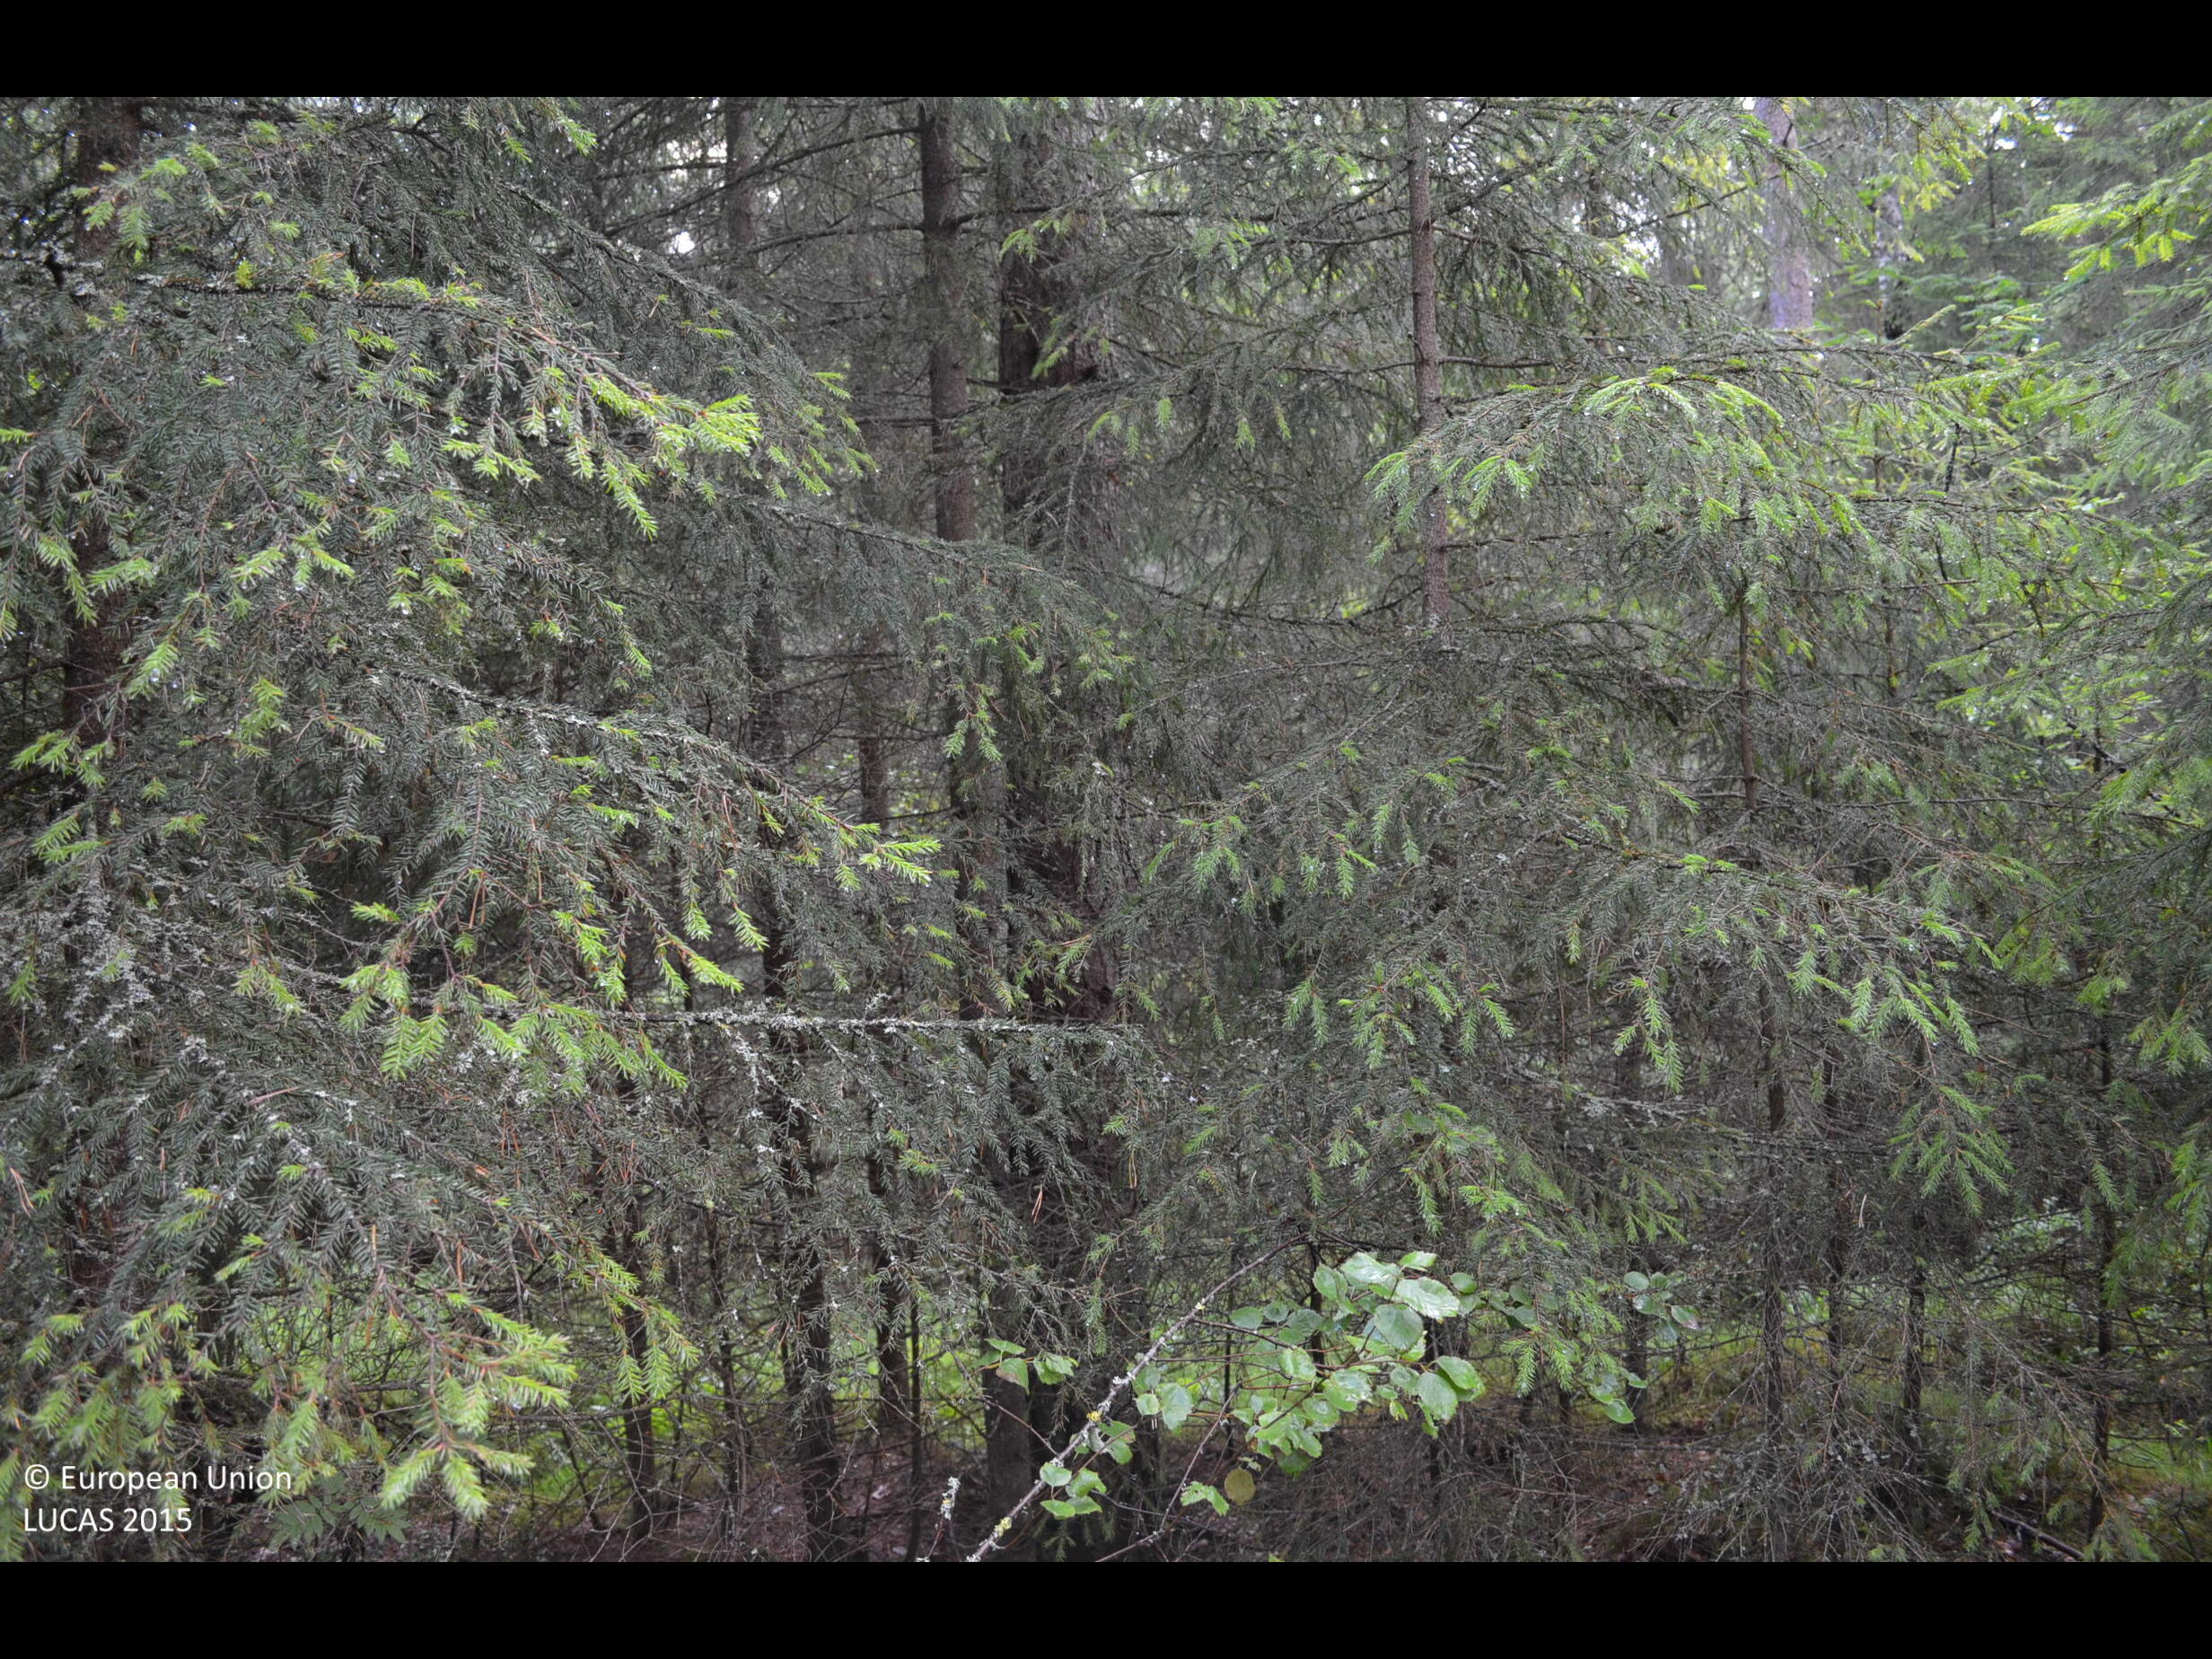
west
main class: Woodland
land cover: Other coniferous woodland
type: boreal forest
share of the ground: > 75 %
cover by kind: coniferous forest trees 85 %, shrubs 10 %, broadleaved forest trees 5 %
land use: Forestry
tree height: > 5 m
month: July
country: FI
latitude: 62.1732
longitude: 23.4185
